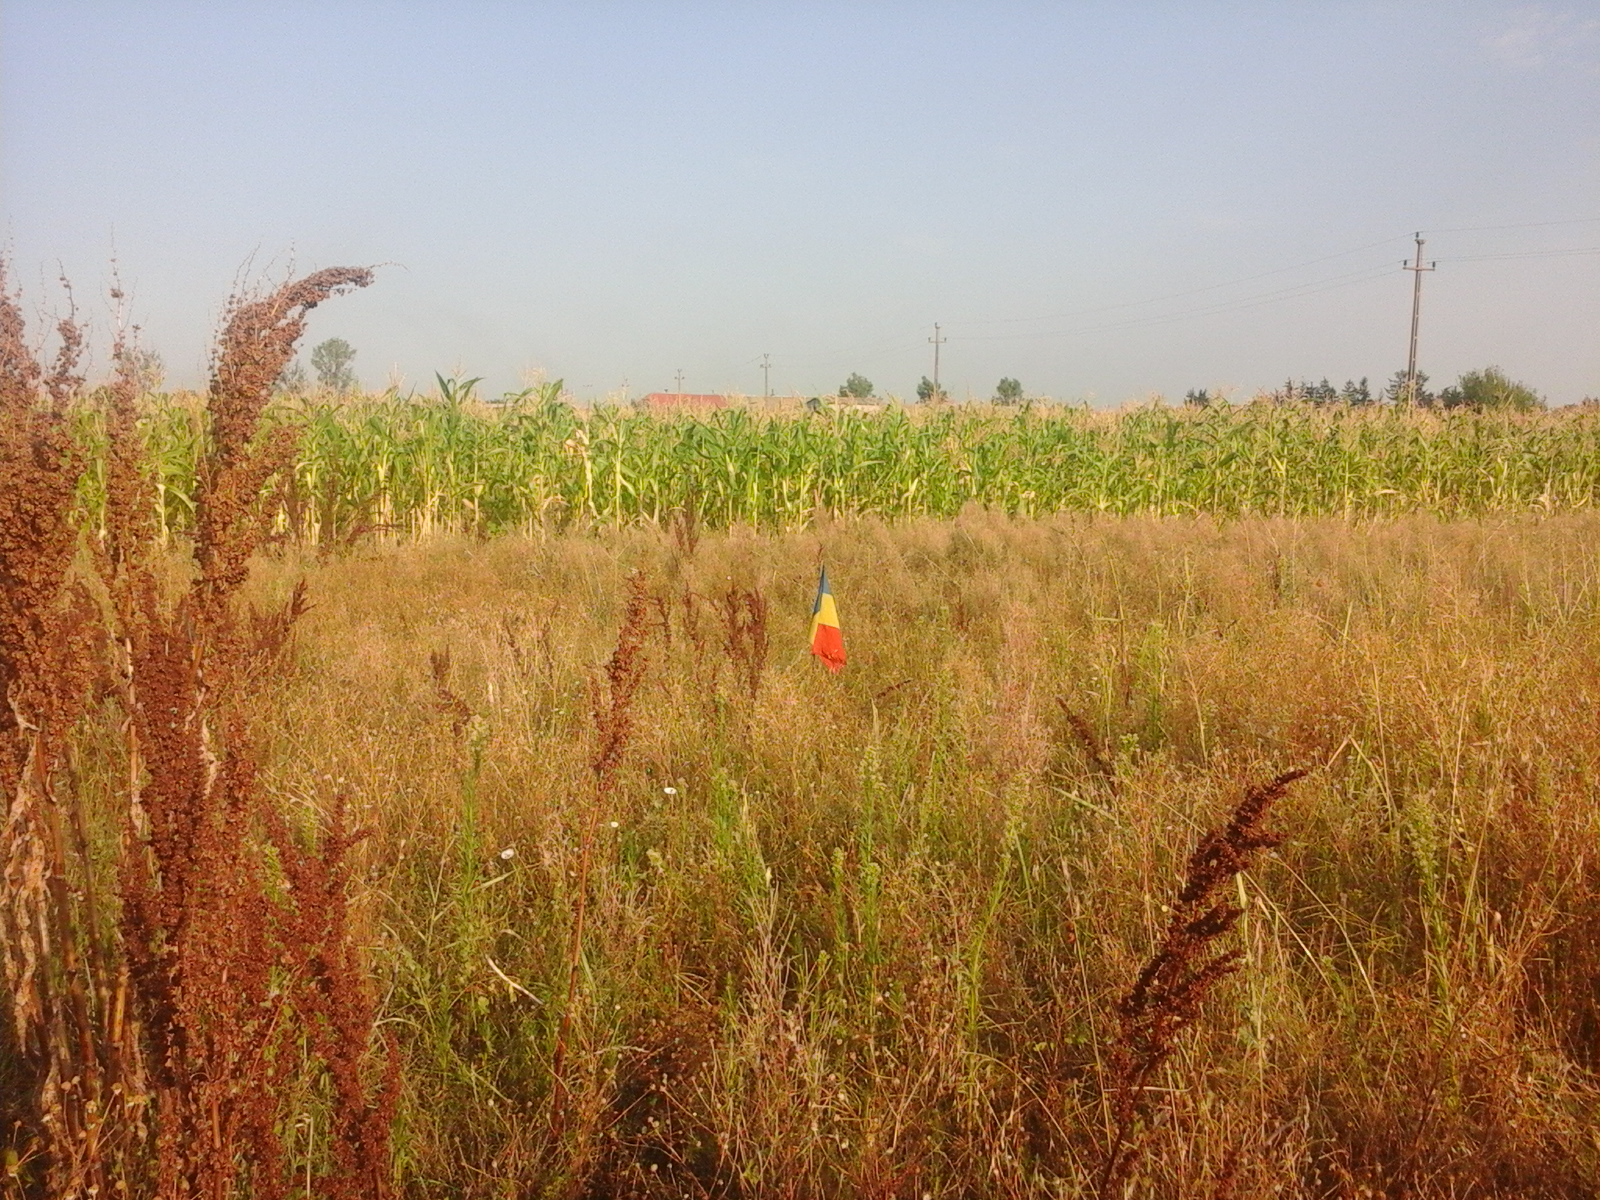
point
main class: Grassland
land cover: Spontaneously vegetated surfaces
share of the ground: > 75 %
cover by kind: herbaceous plants 100 %
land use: Fallow land
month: August
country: RO
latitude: 44.1582
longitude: 23.7720
